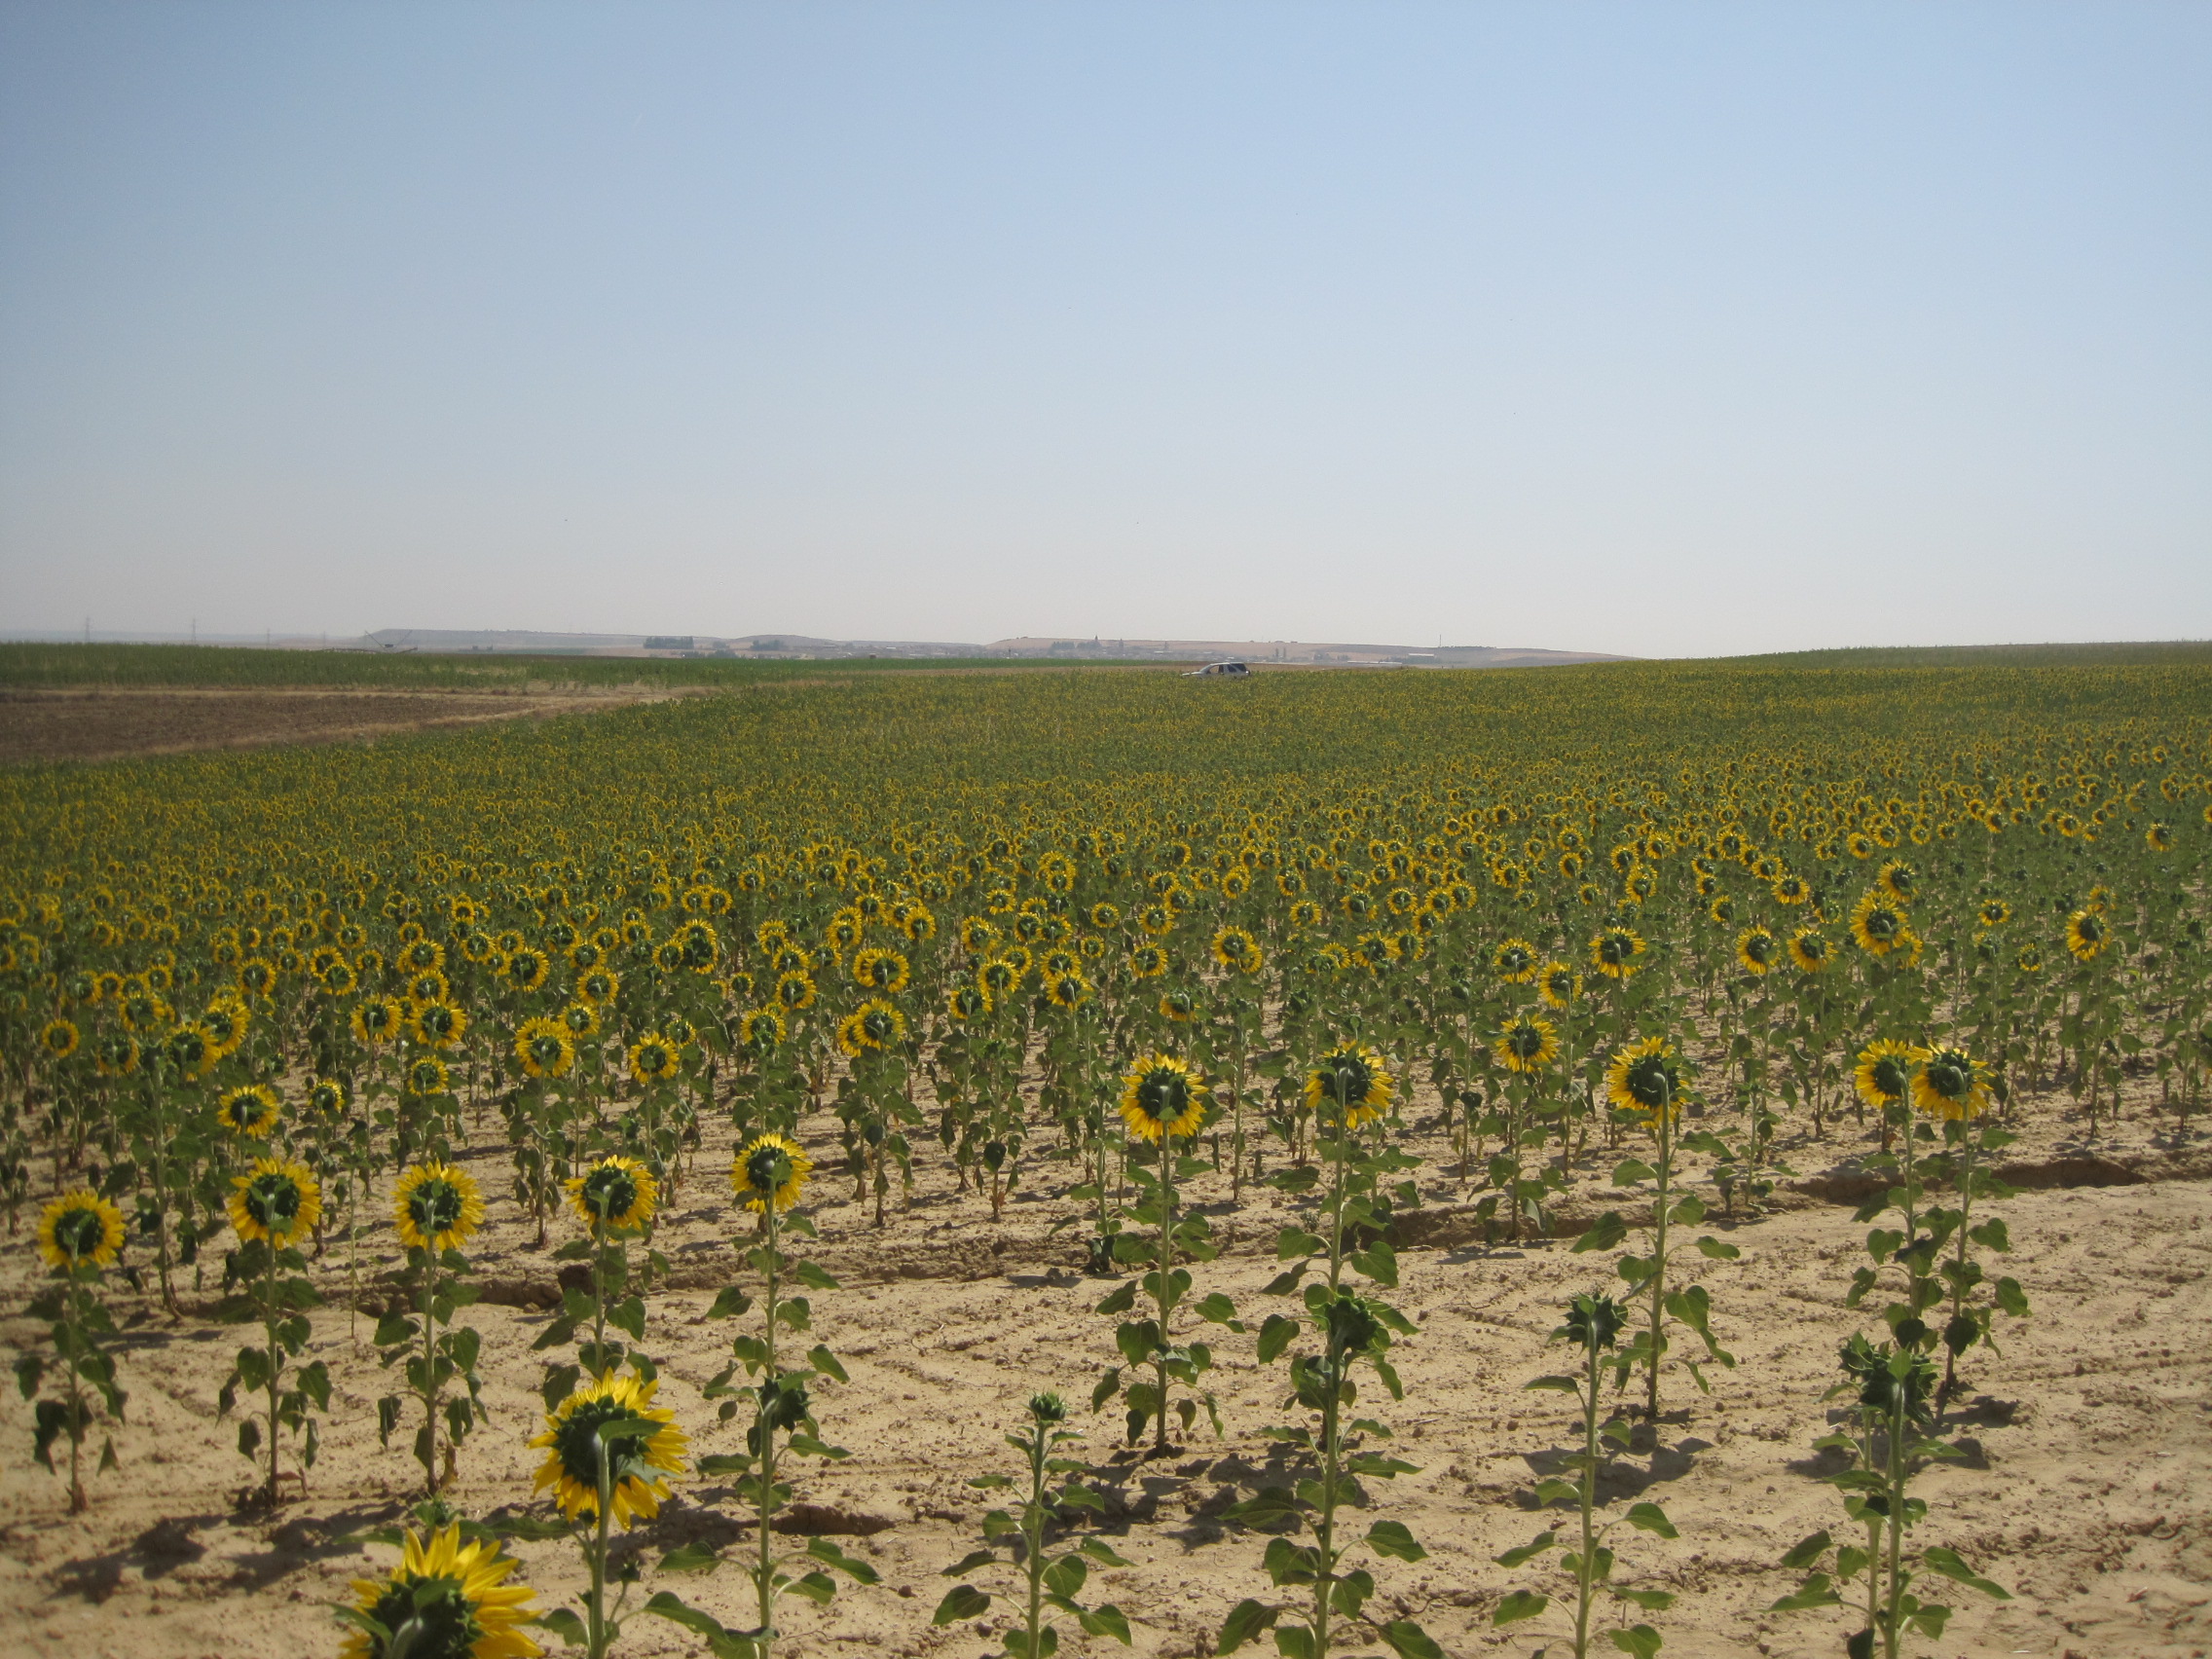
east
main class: Cropland
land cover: Sunflower
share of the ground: > 75 %
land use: Agriculture (excluding fallow land and kitchen gardens)
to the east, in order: Sunflower; Grass margins; Tracks; Grass margins; Sunflower
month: July
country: ES
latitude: 41.6493
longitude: -5.4149
